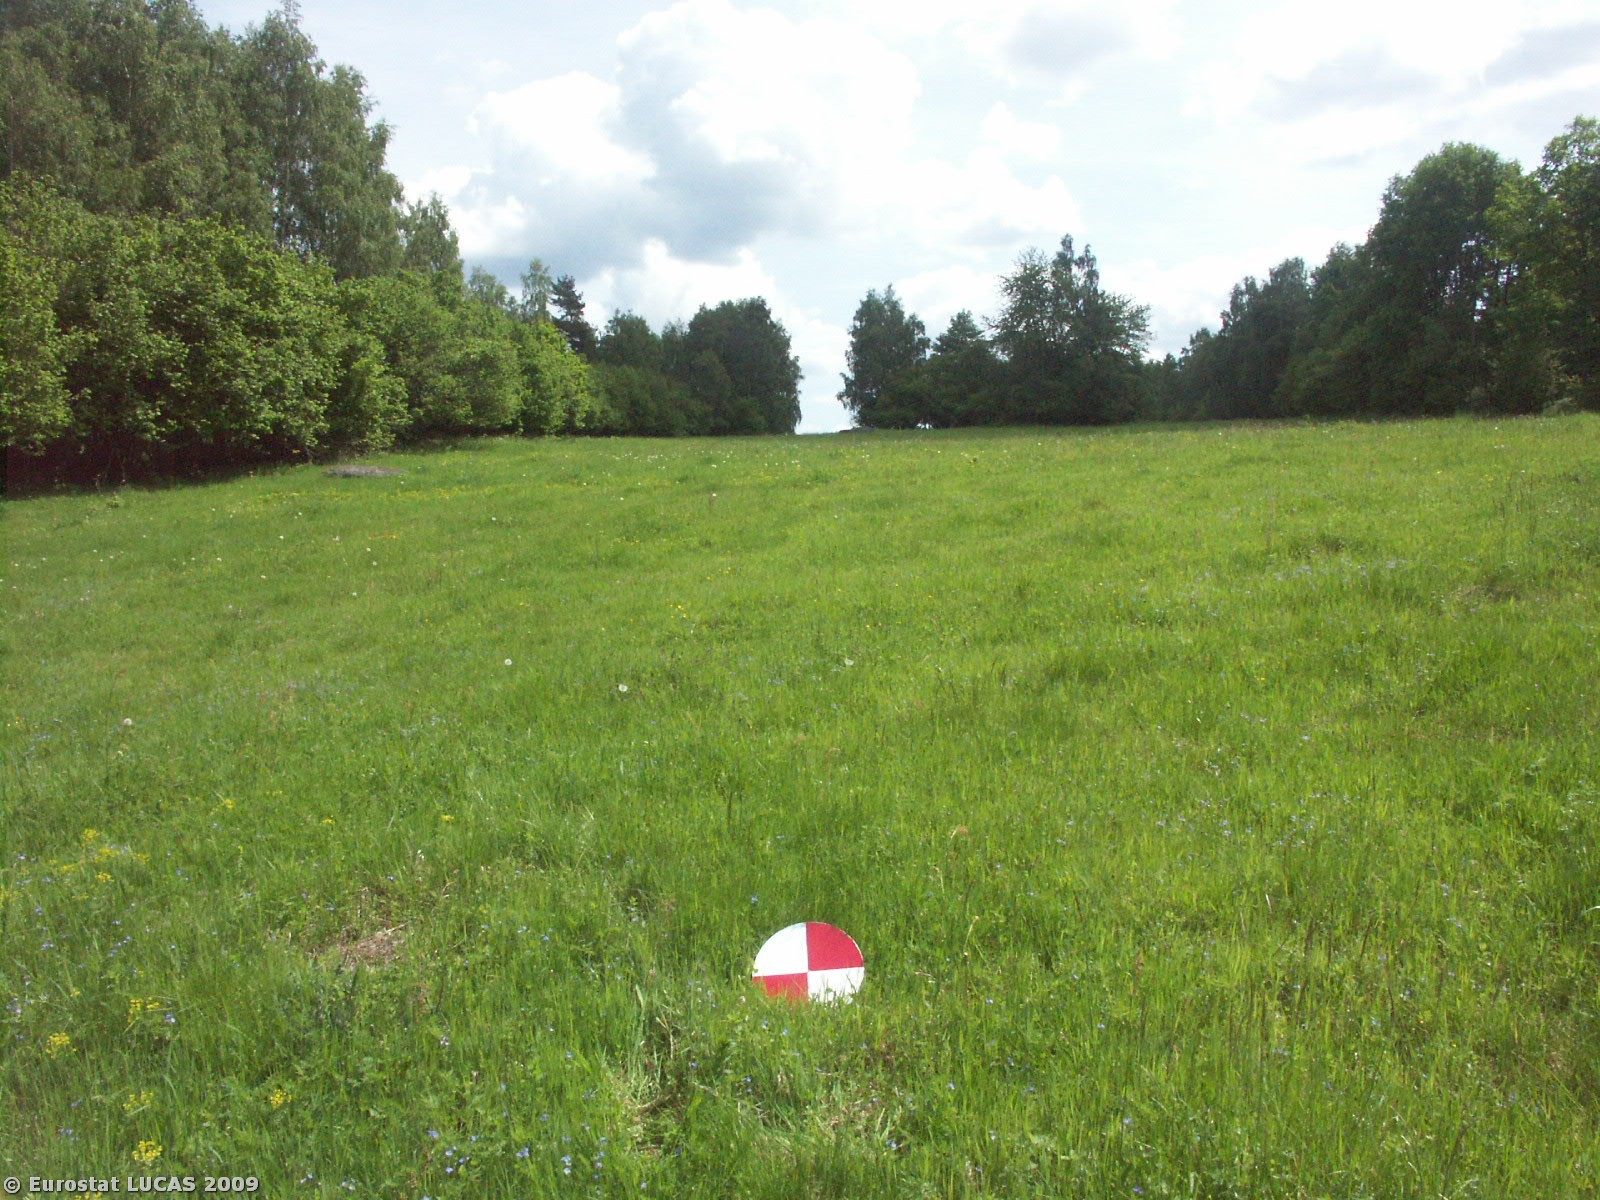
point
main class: Grassland
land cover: Grassland without tree/shrub cover
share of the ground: > 75 %
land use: Agriculture (excluding fallow land and kitchen gardens)
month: May
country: CZ
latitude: 48.7219
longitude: 14.6092
